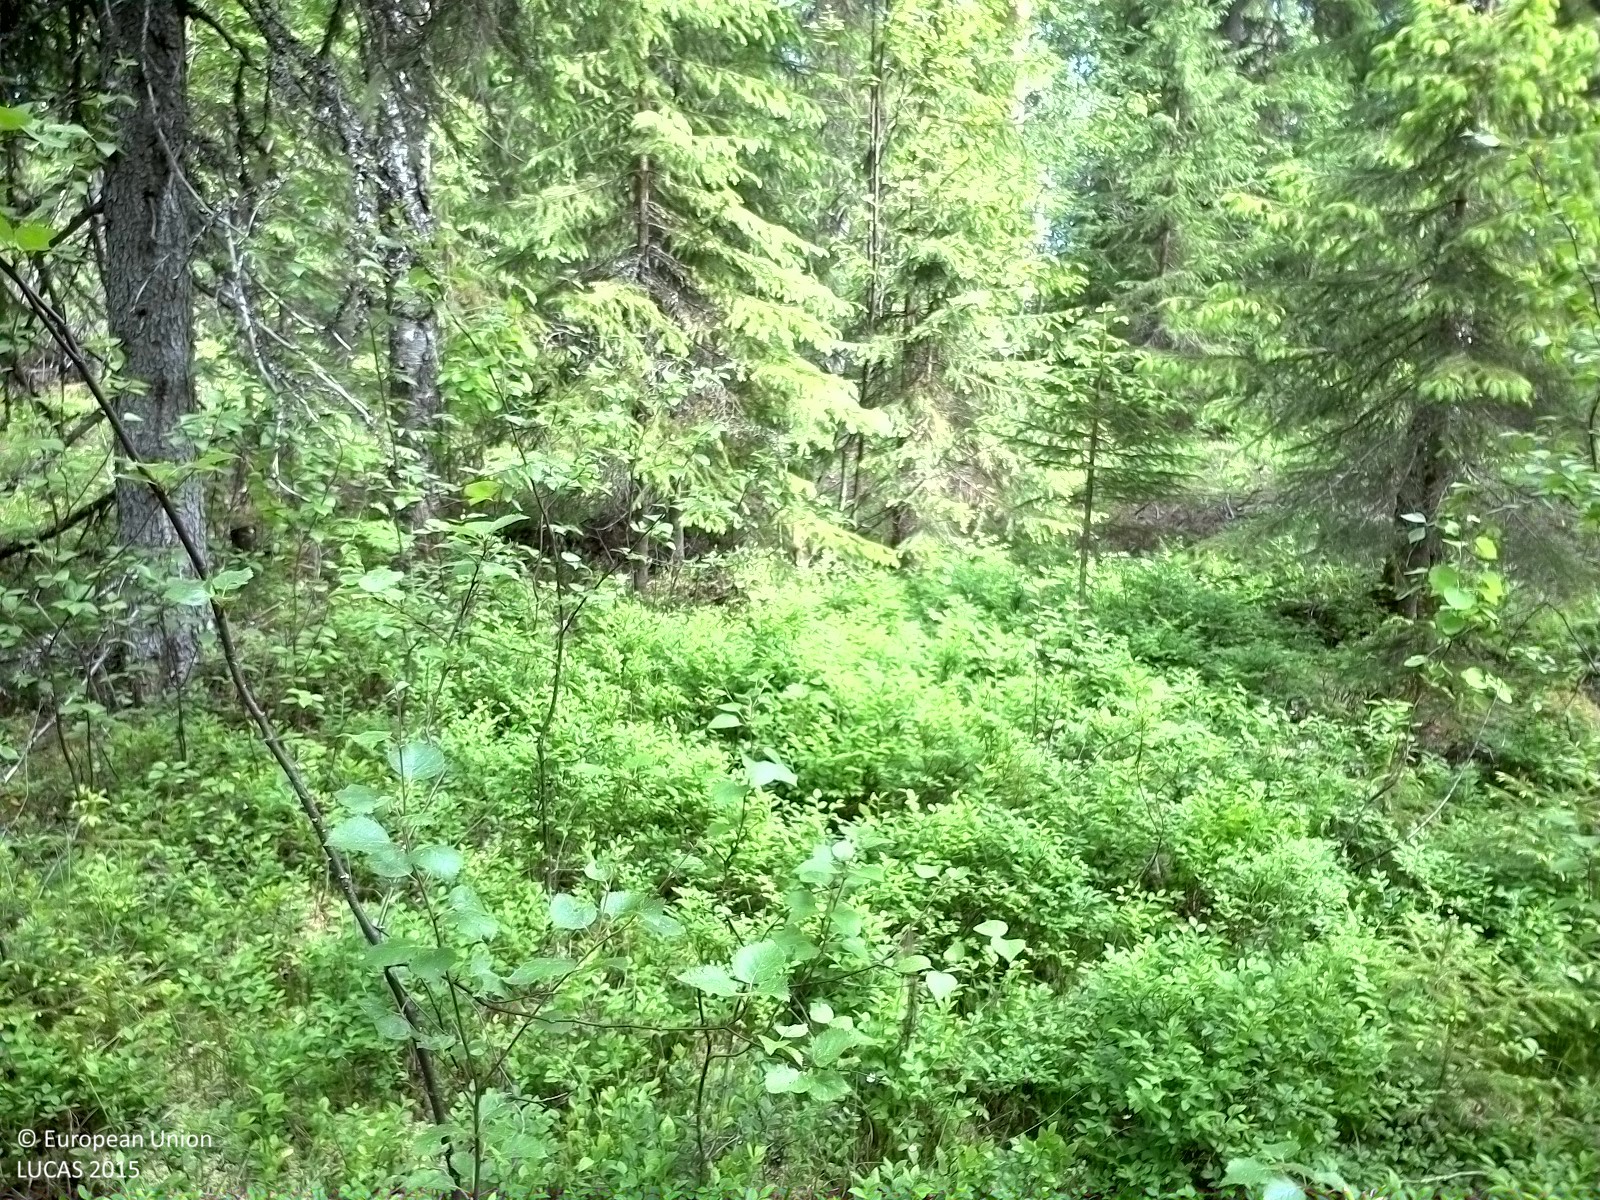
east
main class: Woodland
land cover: Spruce dominated coniferous woodland
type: boreal forest
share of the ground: 25 - 50 %
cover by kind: coniferous forest trees 40 %, lichens and mosses 30 %, shrubs 25 %, broadleaved forest trees 5 %
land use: Forestry
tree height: > 5 m
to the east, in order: Spruce dominated coniferous woodland; Ditches and canals; Paved roads, cycling and walking lanes; Ditches and canals; Spruce dominated coniferous woodland; Other mixed woodland; Spruce dominated coniferous woodland; Ditches and canals; Spruce dominated coniferous woodland
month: July
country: SE
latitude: 62.1495
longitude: 16.8313
